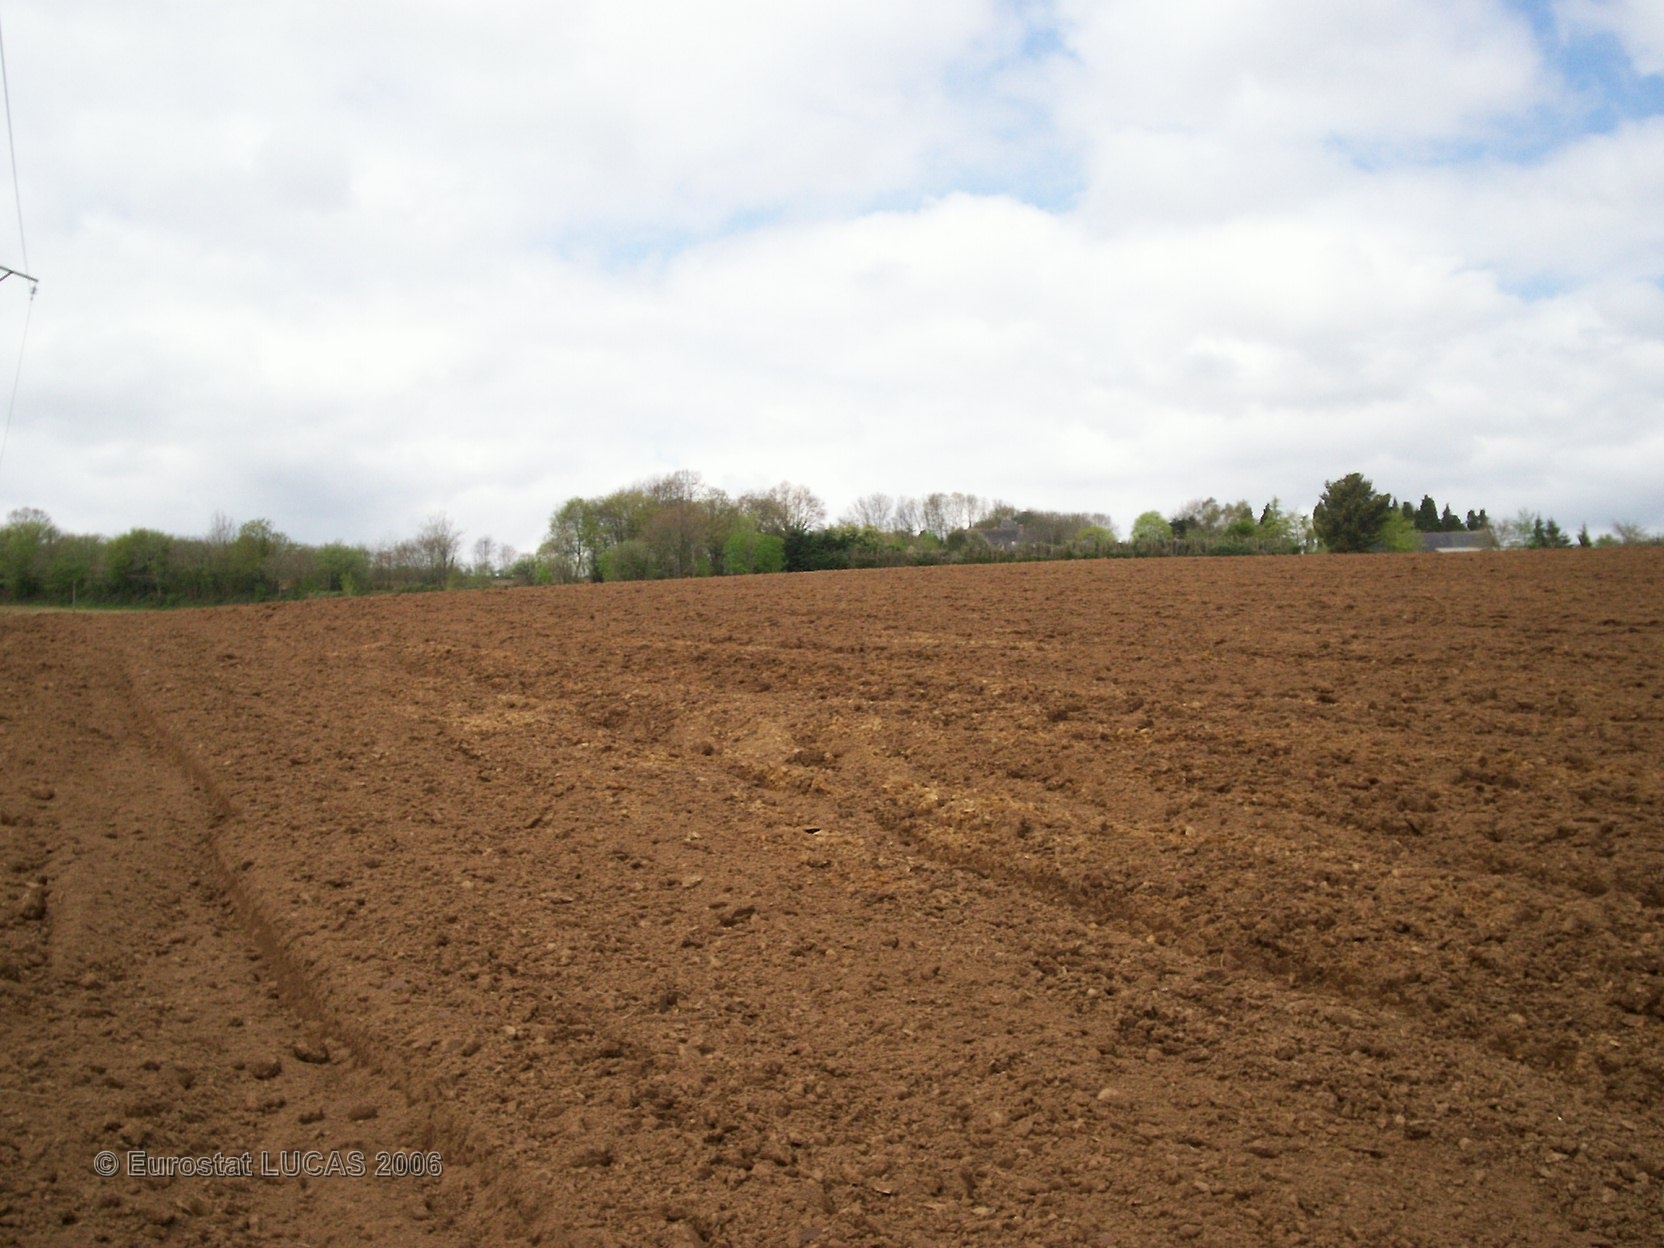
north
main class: Cropland
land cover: Maize
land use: Agriculture (excluding fallow land and kitchen gardens)
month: June
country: FR
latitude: 48.3456
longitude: -3.7238
